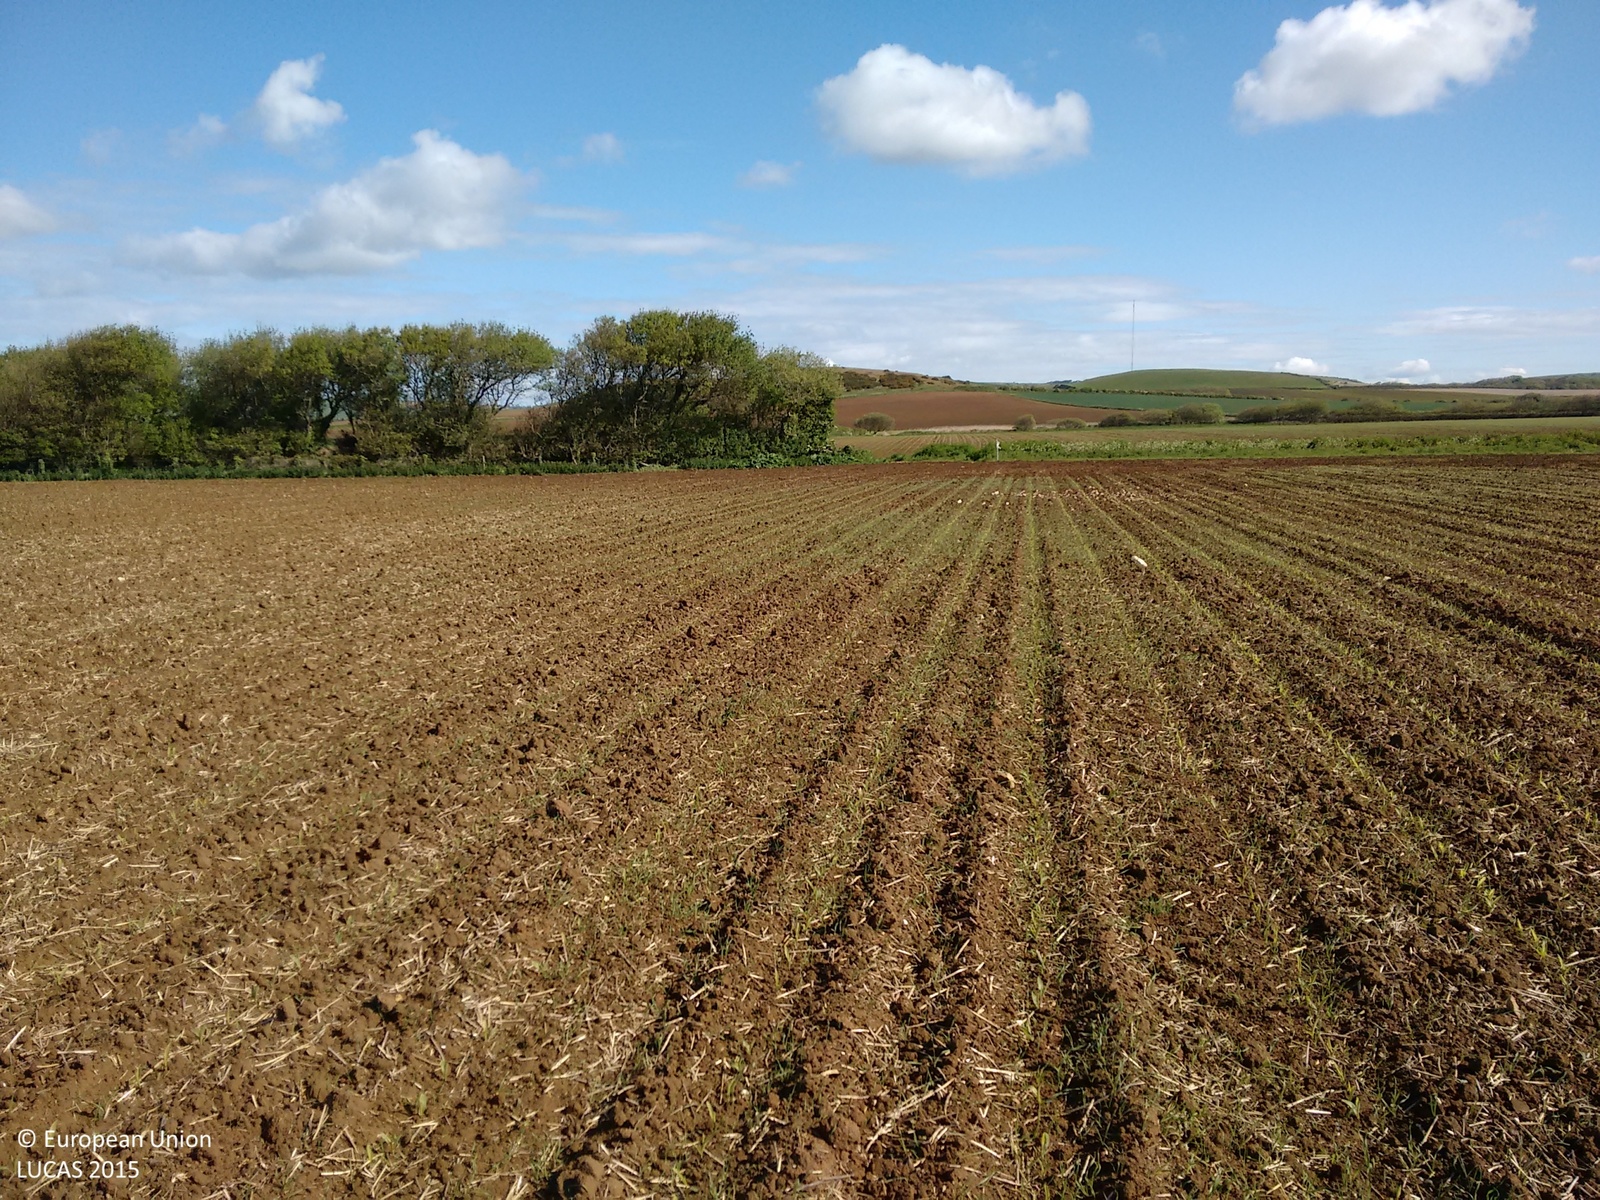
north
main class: Cropland
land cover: Maize
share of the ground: < 10 %
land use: Agriculture (excluding fallow land and kitchen gardens)
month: May
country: GB
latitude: 50.6152
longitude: -1.3407
